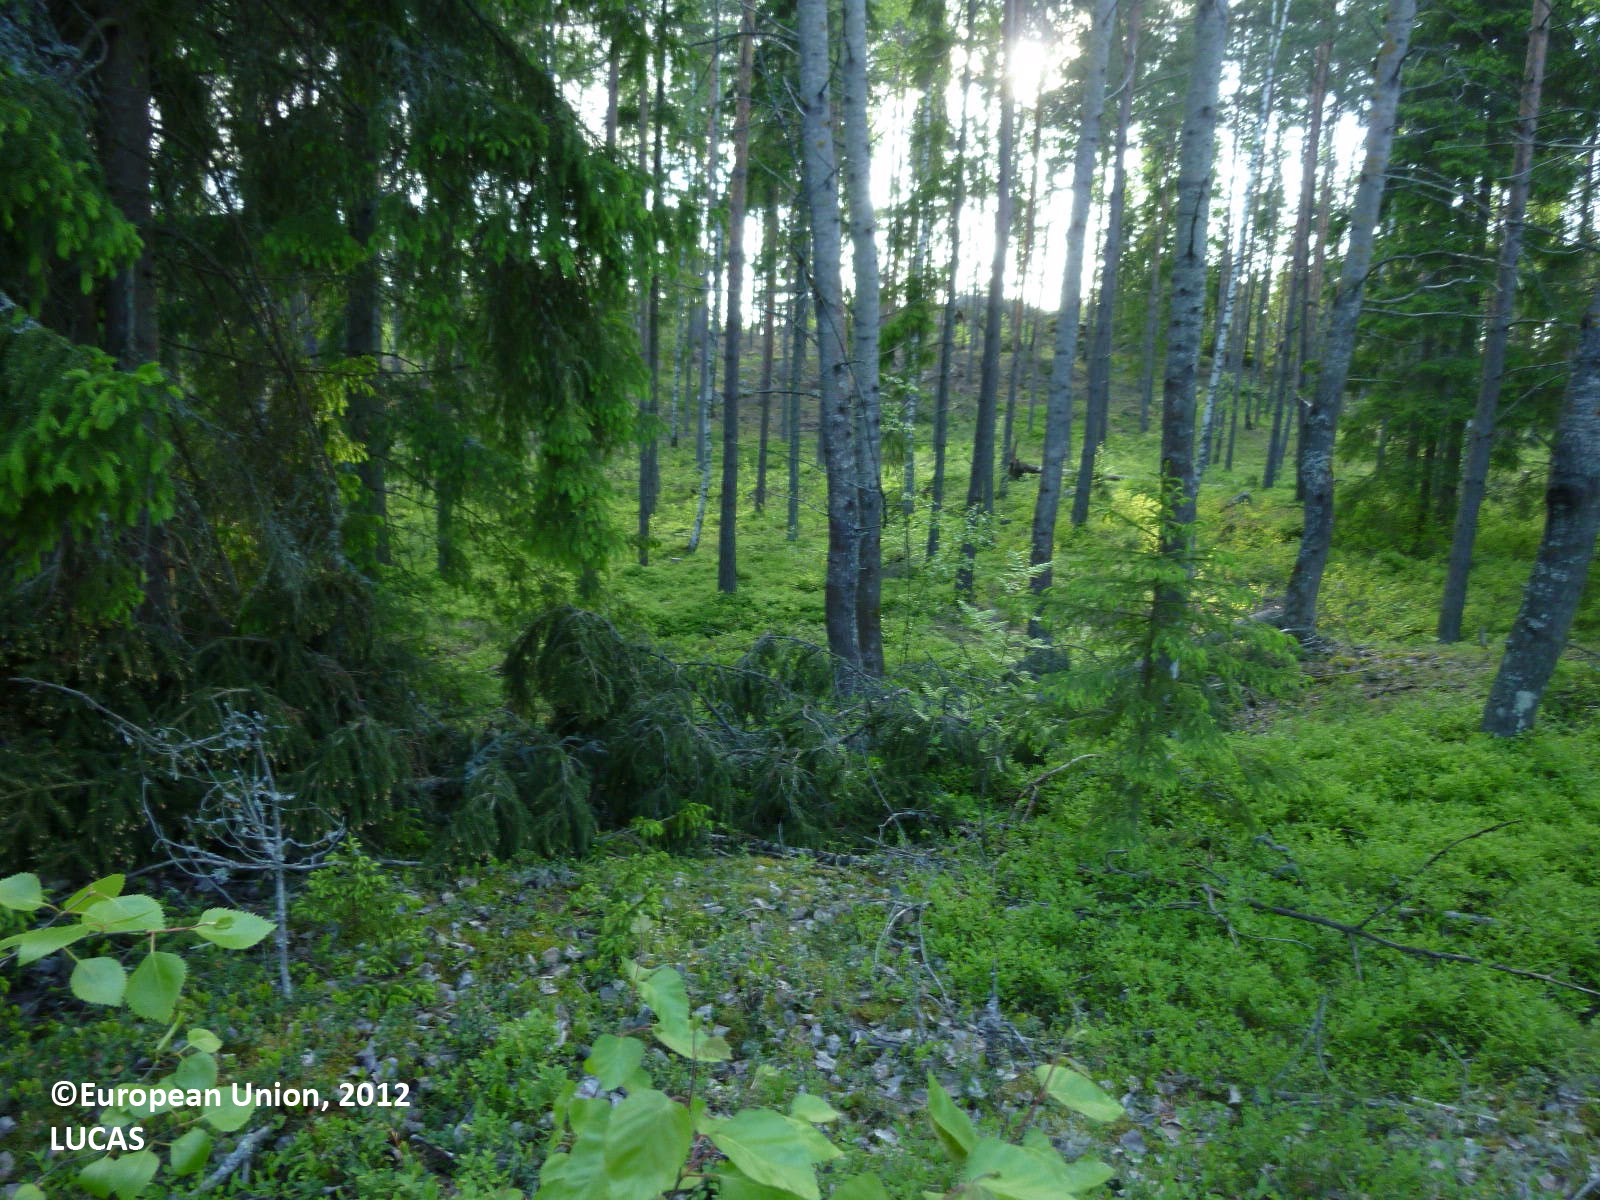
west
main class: Woodland
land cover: Pine dominated mixed woodland
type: boreal forest
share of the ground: 25 - 50 %
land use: Forestry
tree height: > 5 m
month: June
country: FI
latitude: 60.3441
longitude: 22.5926
